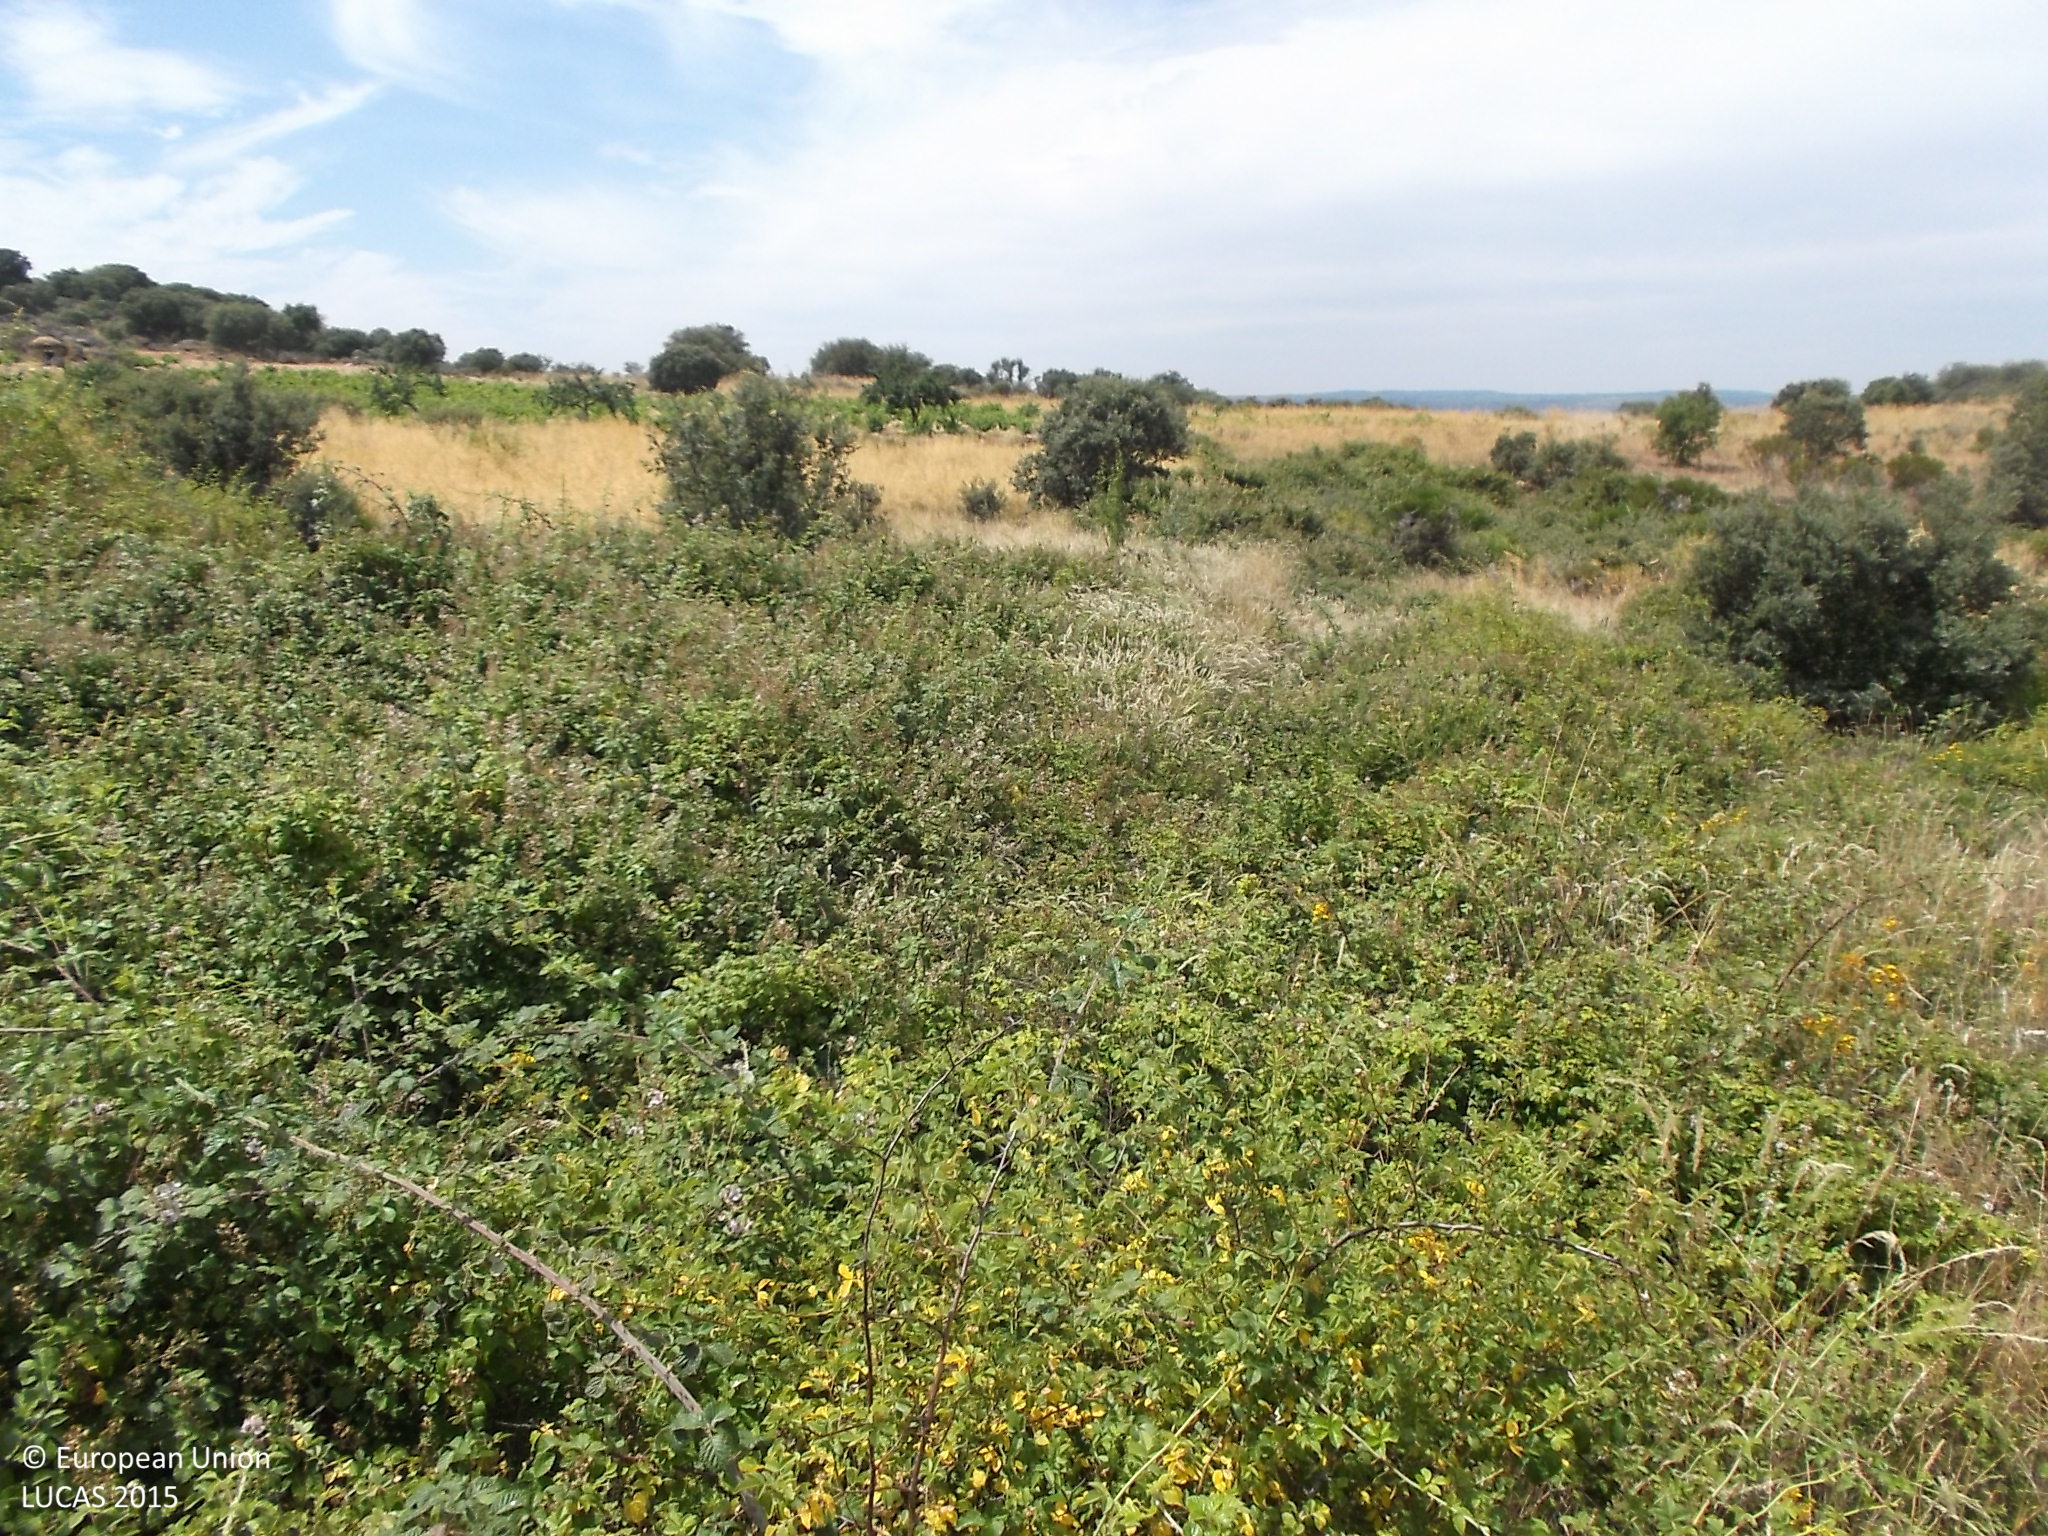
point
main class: Shrubland
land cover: Shrubland without tree cover
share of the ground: > 75 %
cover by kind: shrubs 100 %
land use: Semi-natural and natural areas not in use
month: July
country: ES
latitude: 41.3142
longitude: -6.3544
